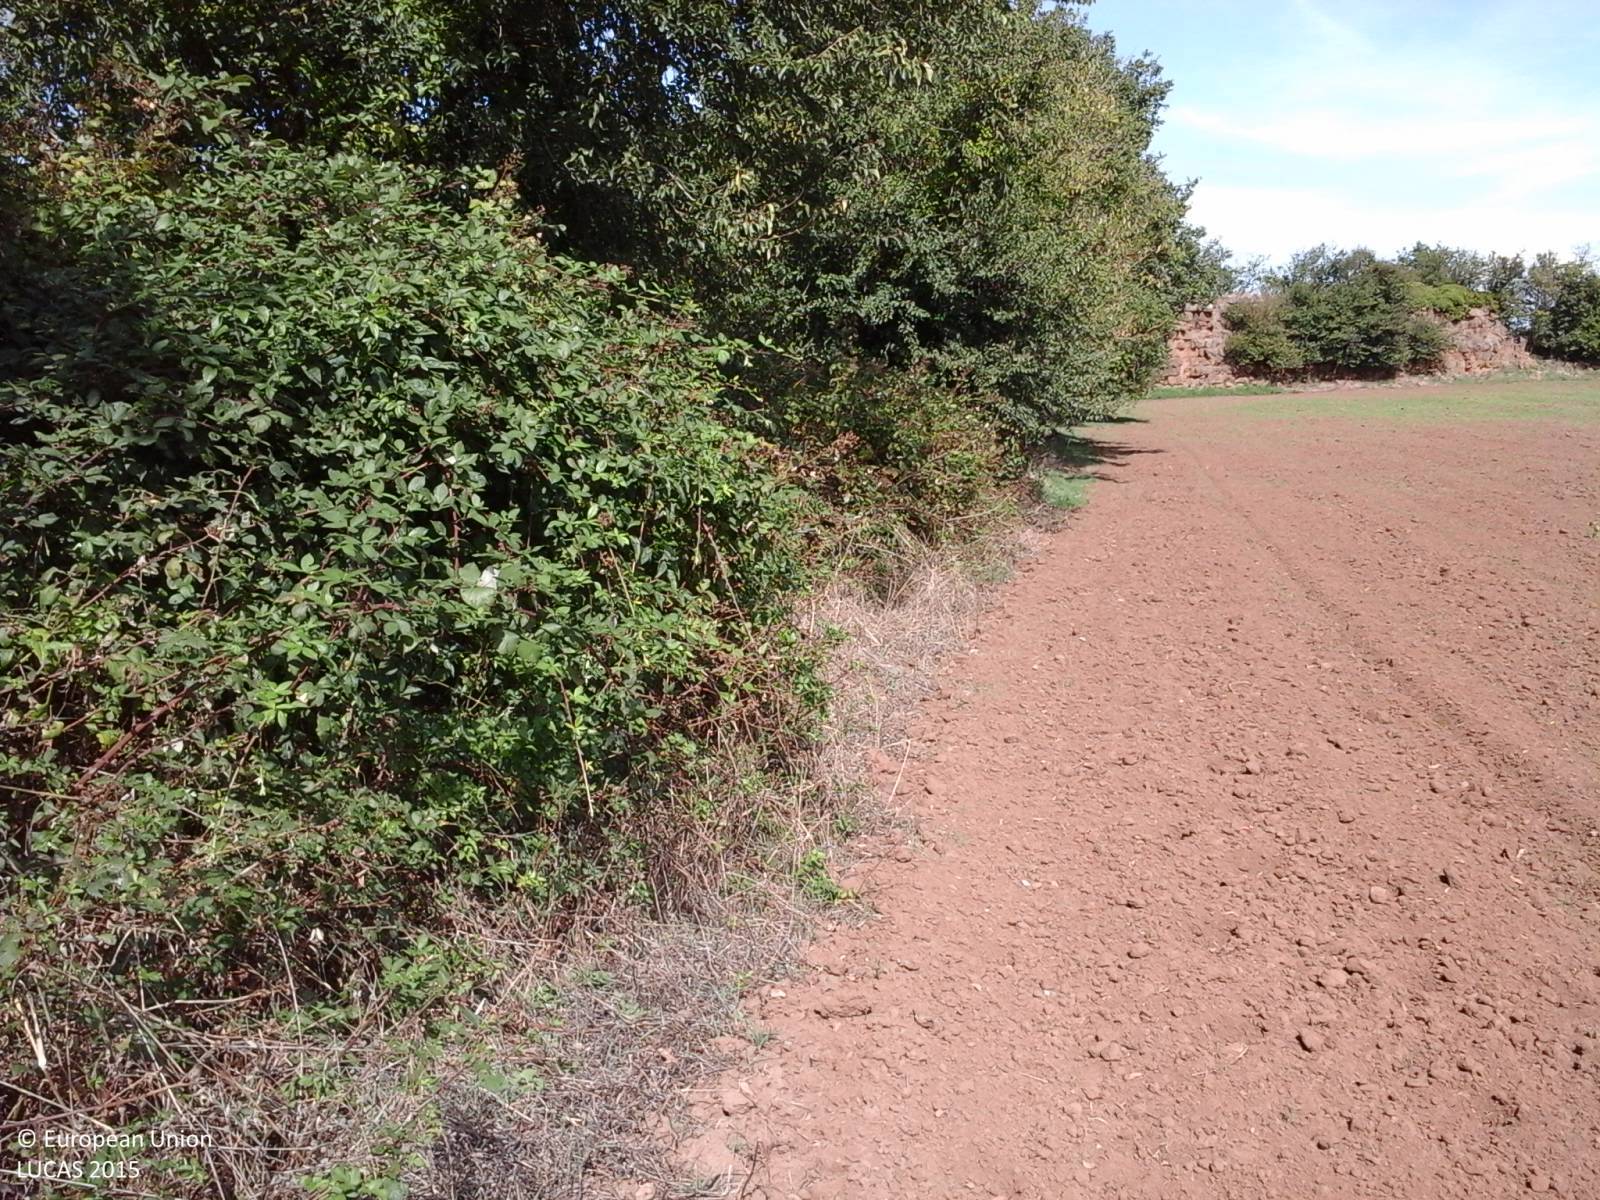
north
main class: Cropland
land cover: Oats
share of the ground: < 10 %
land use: Agriculture (excluding fallow land and kitchen gardens)
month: September
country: IT
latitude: 42.3013
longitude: 12.3572
